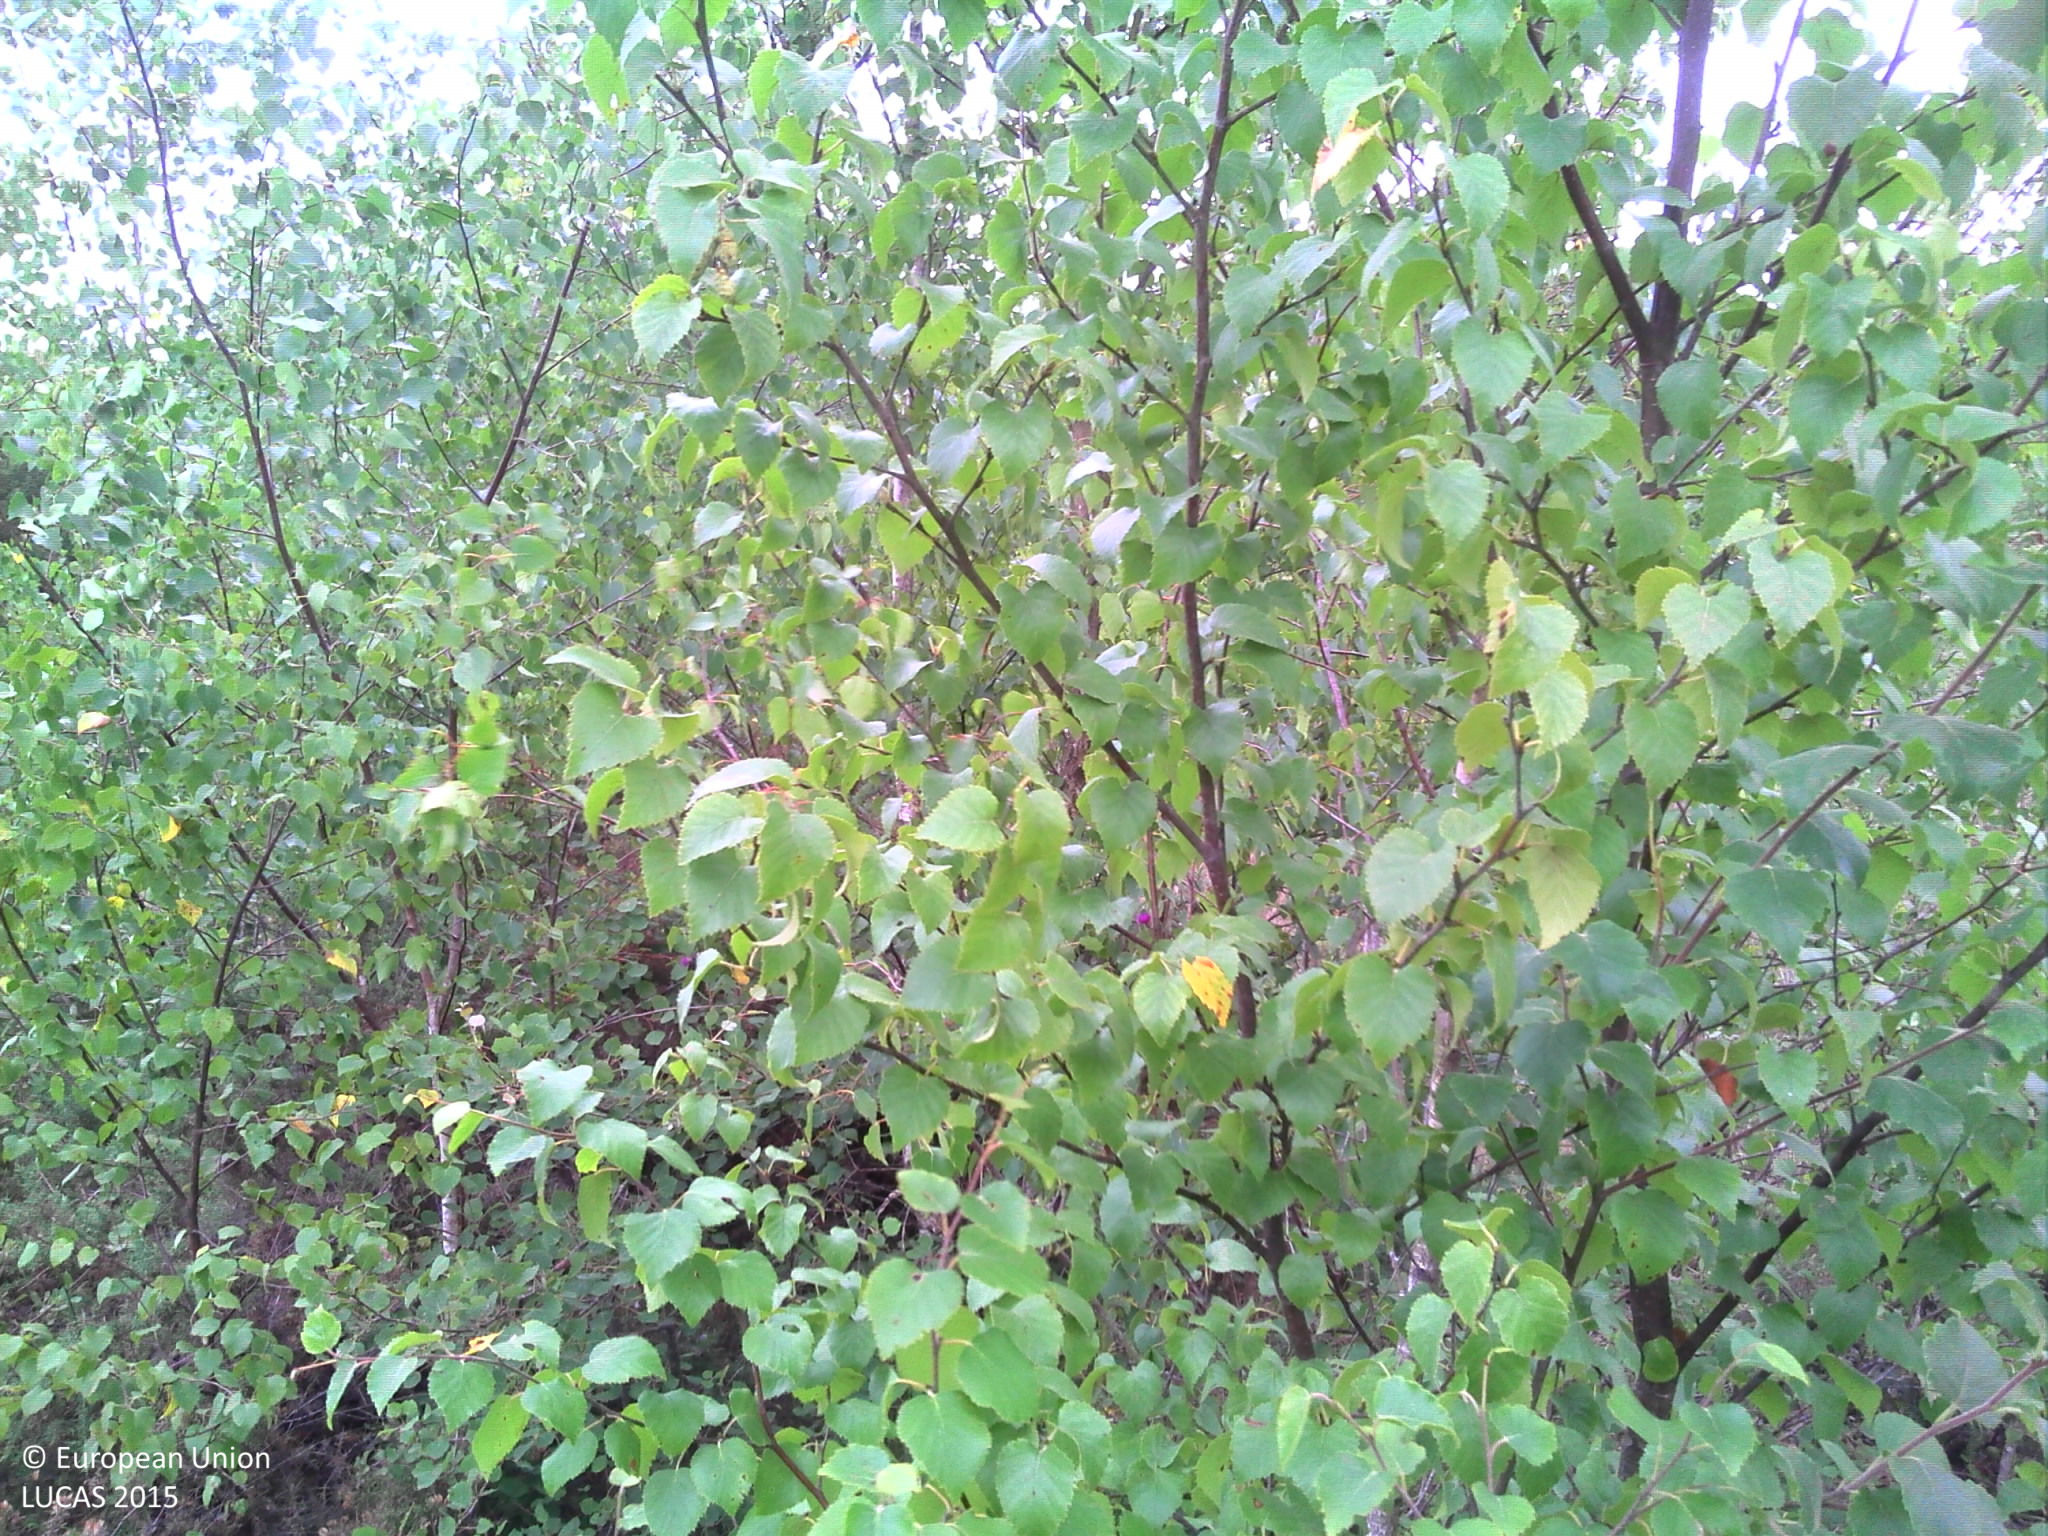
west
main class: Woodland
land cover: Broadleaved woodland
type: mesophytic deciduous forest
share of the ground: > 75 %
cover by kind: broadleaved forest trees 50 %, herbaceous plants 40 %, coniferous forest trees 10 %
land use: Forestry
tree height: < 5 m
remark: Temporary flooded
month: July
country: FR
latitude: 47.5650
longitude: -1.8373
